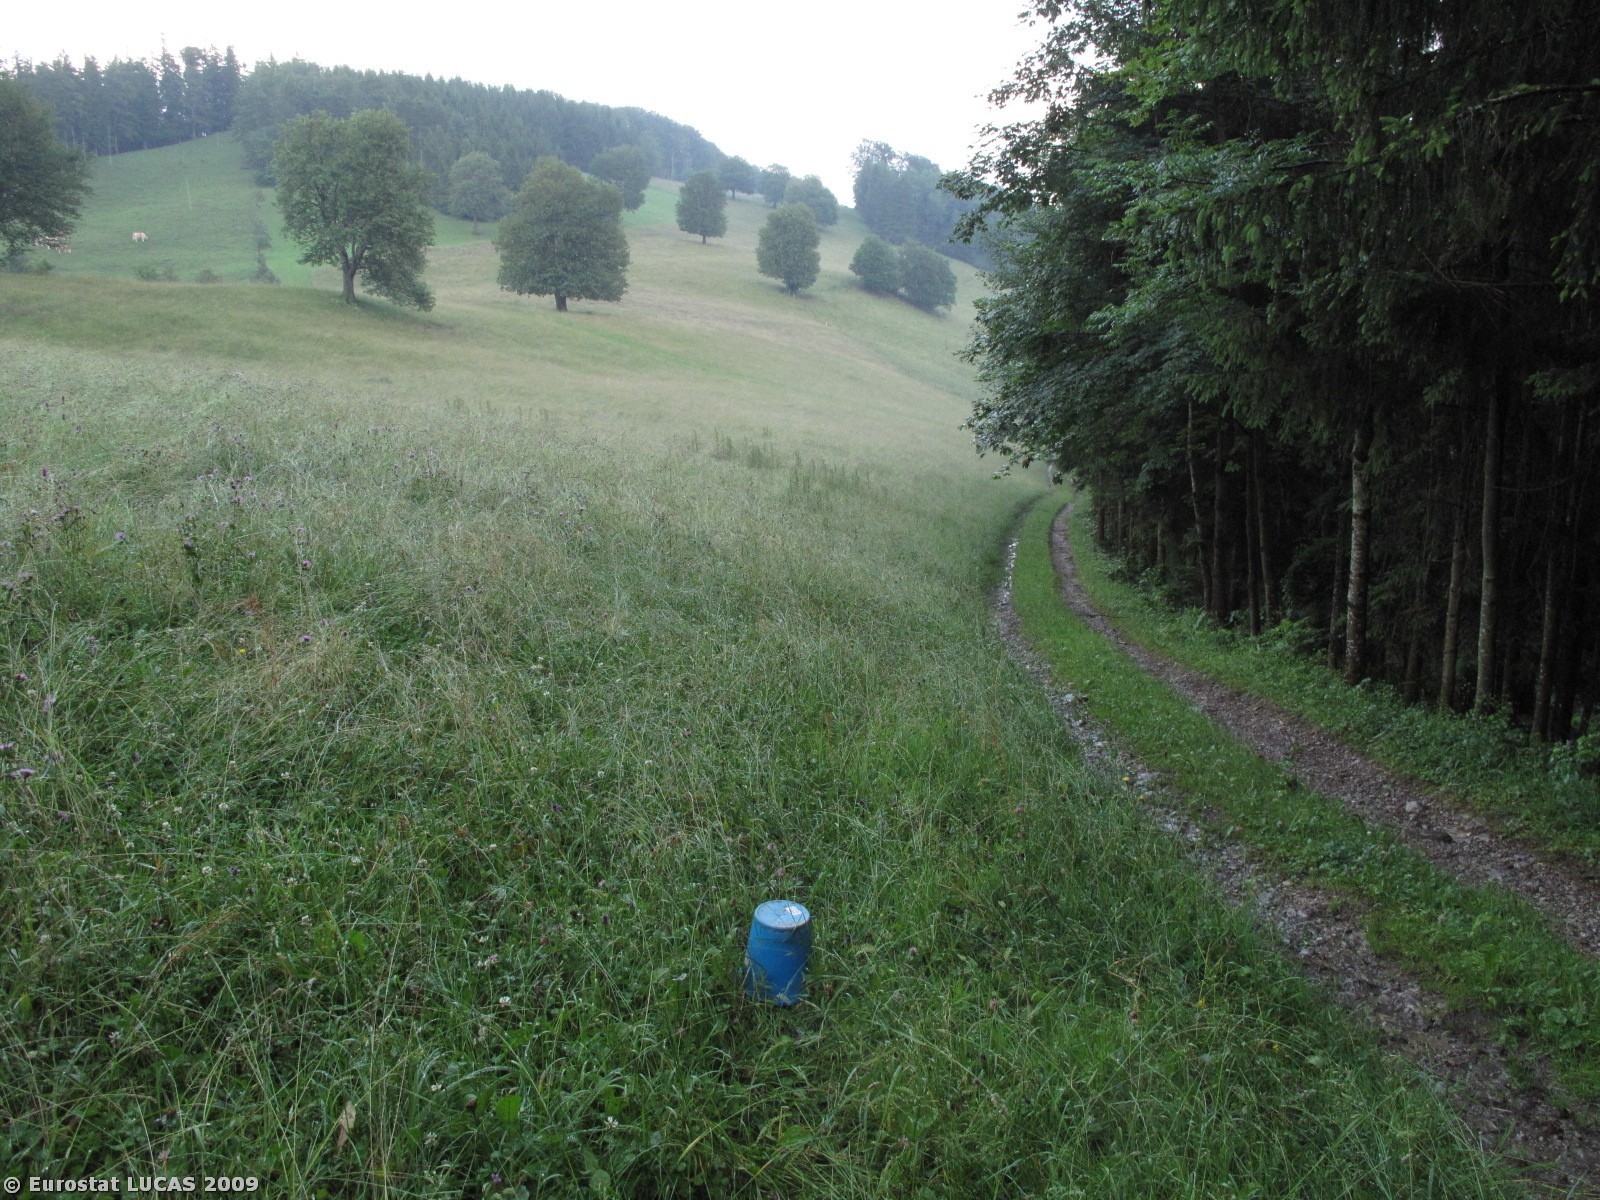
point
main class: Grassland
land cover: Grassland without tree/shrub cover
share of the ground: > 75 %
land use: Agriculture (excluding fallow land and kitchen gardens)
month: July
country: AT
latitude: 48.0163
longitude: 15.8079
